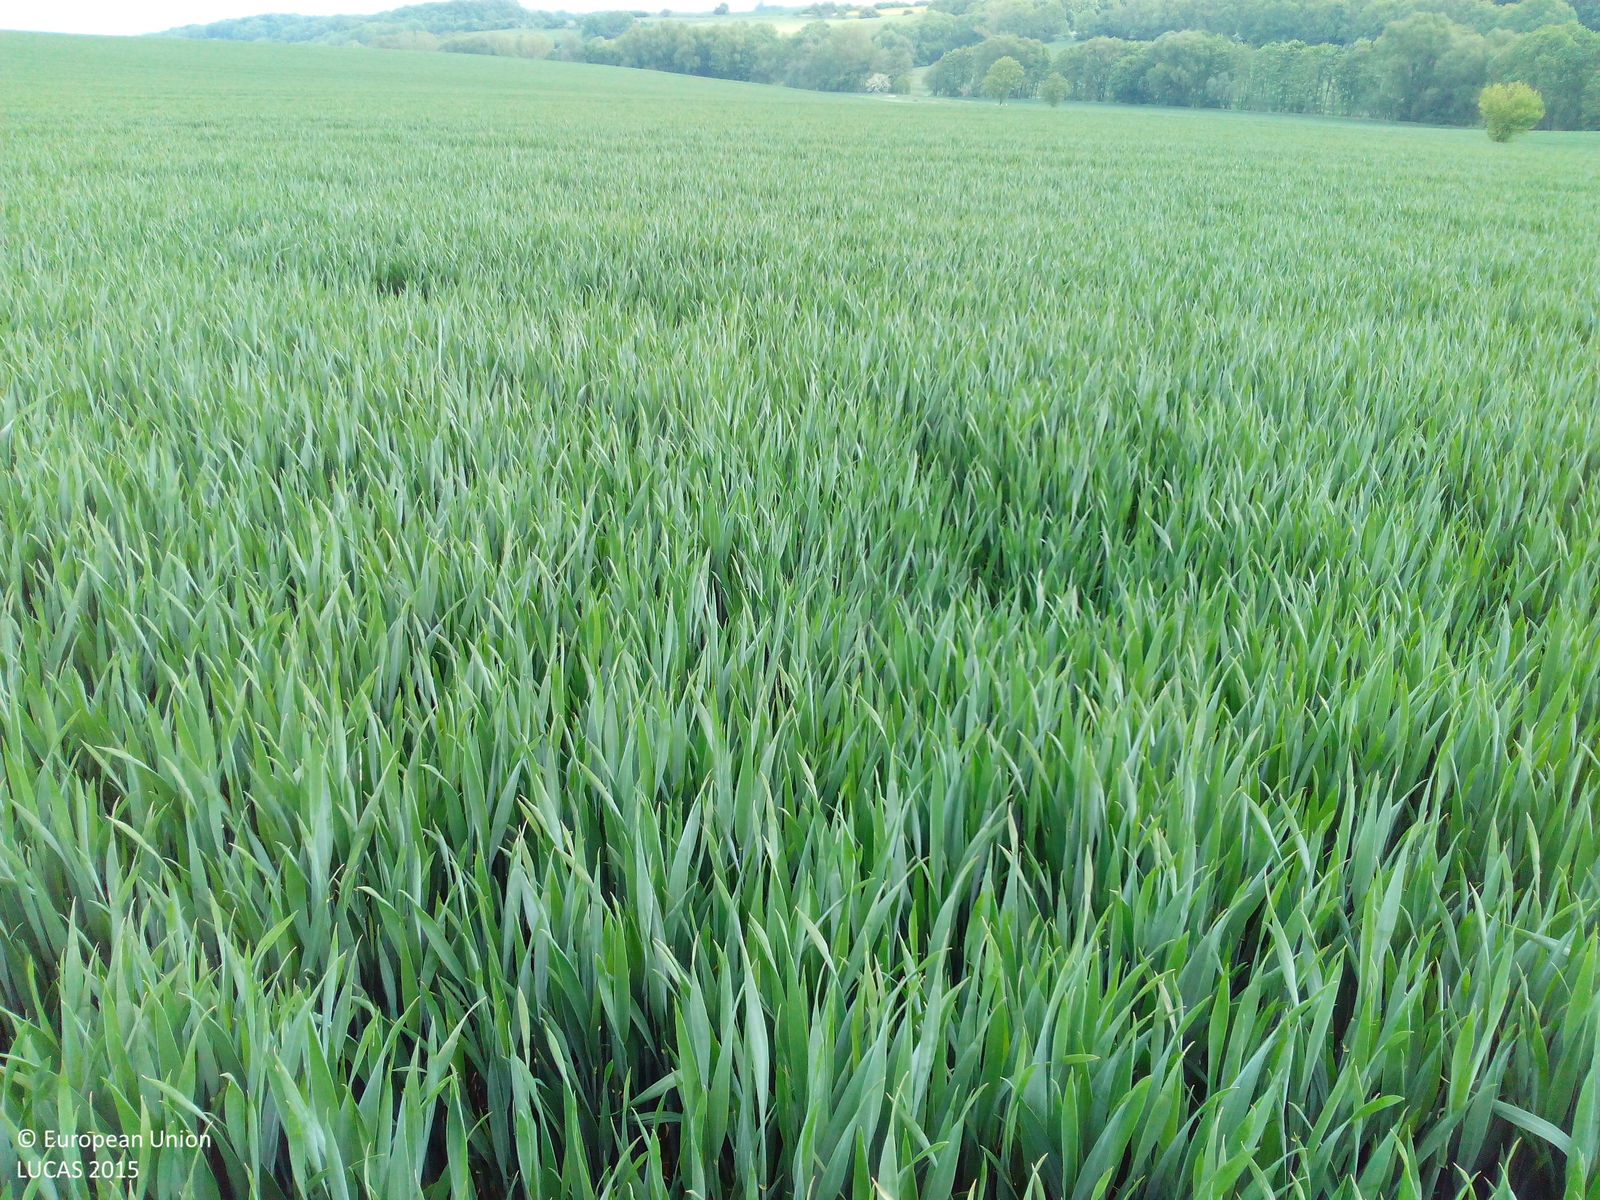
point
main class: Cropland
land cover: Common wheat
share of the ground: > 75 %
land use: Agriculture (excluding fallow land and kitchen gardens)
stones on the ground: < 10 %
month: May
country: DE
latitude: 50.9840
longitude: 11.4669
